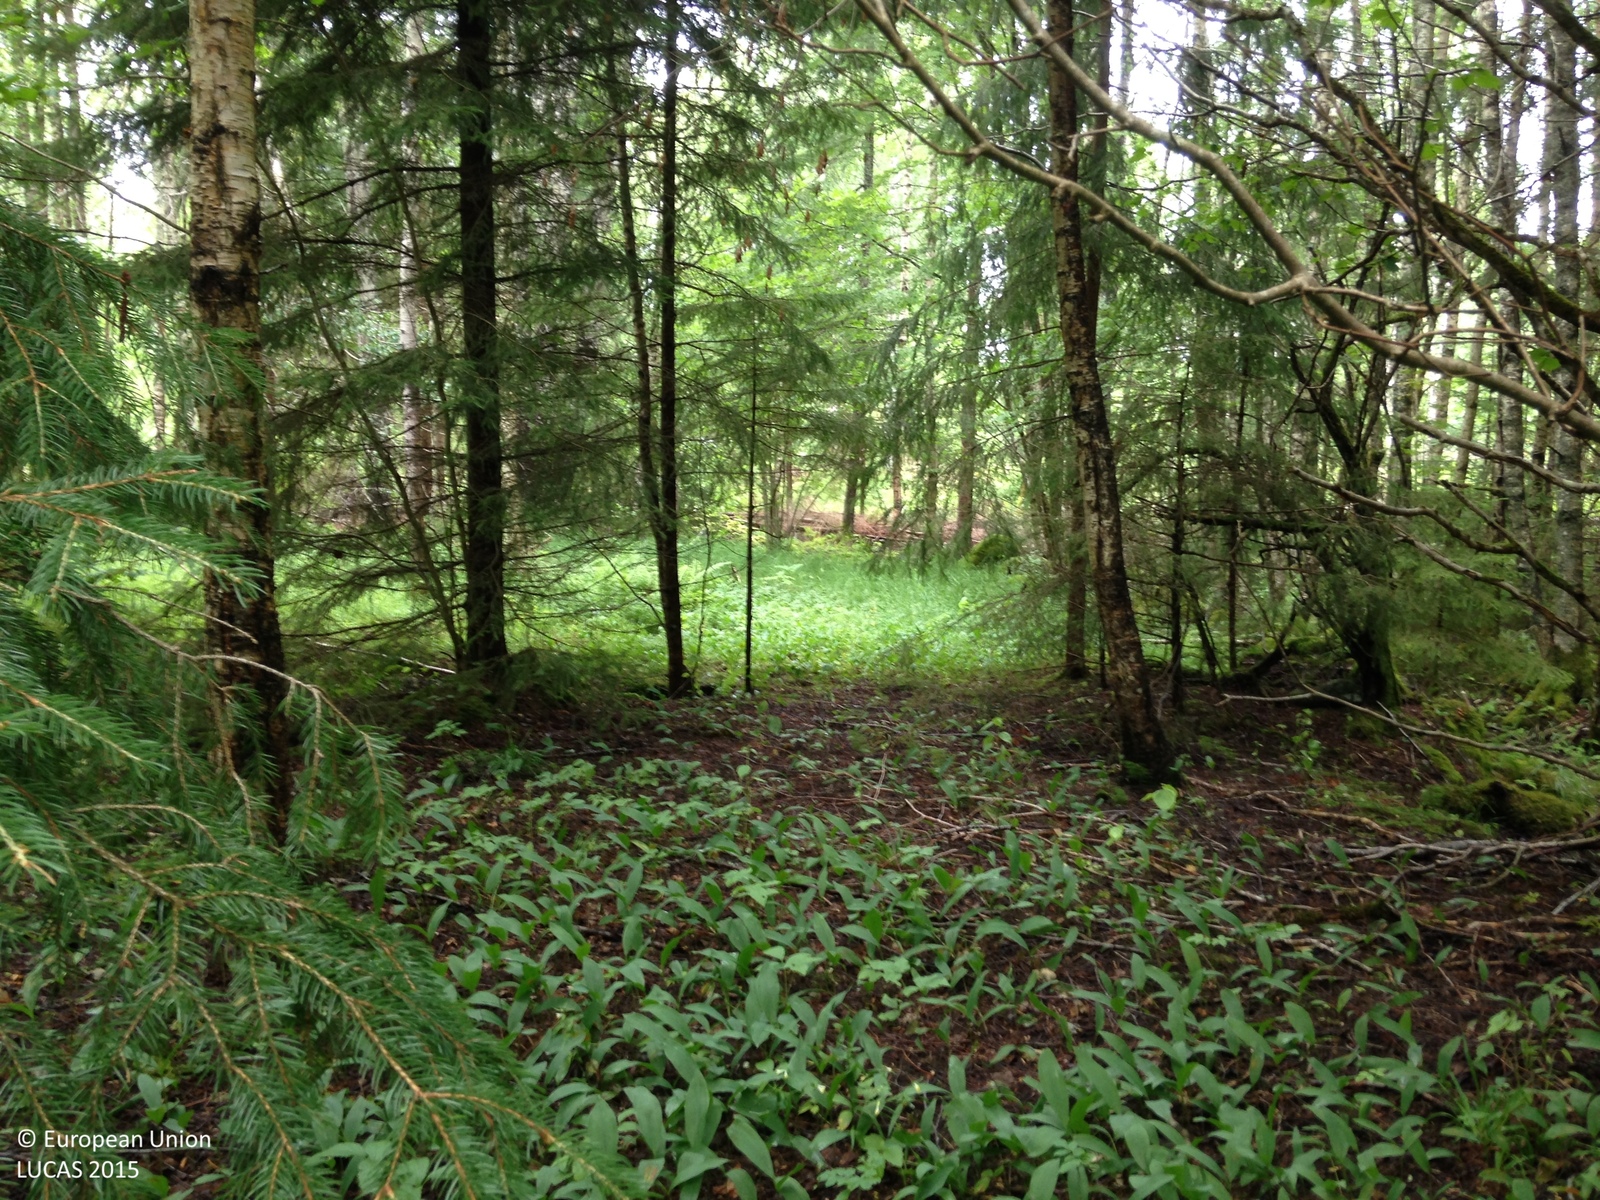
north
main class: Woodland
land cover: Spruce dominated mixed woodland
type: boreal forest
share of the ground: 50 - 75 %
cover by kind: coniferous forest trees 30 %, broadleaved forest trees 30 %, herbaceous plants 25 %, consolidated bare surface 10 %, shrubs 5 %
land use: Forestry
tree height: > 5 m
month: July
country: SE
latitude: 58.9239
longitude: 14.3521
